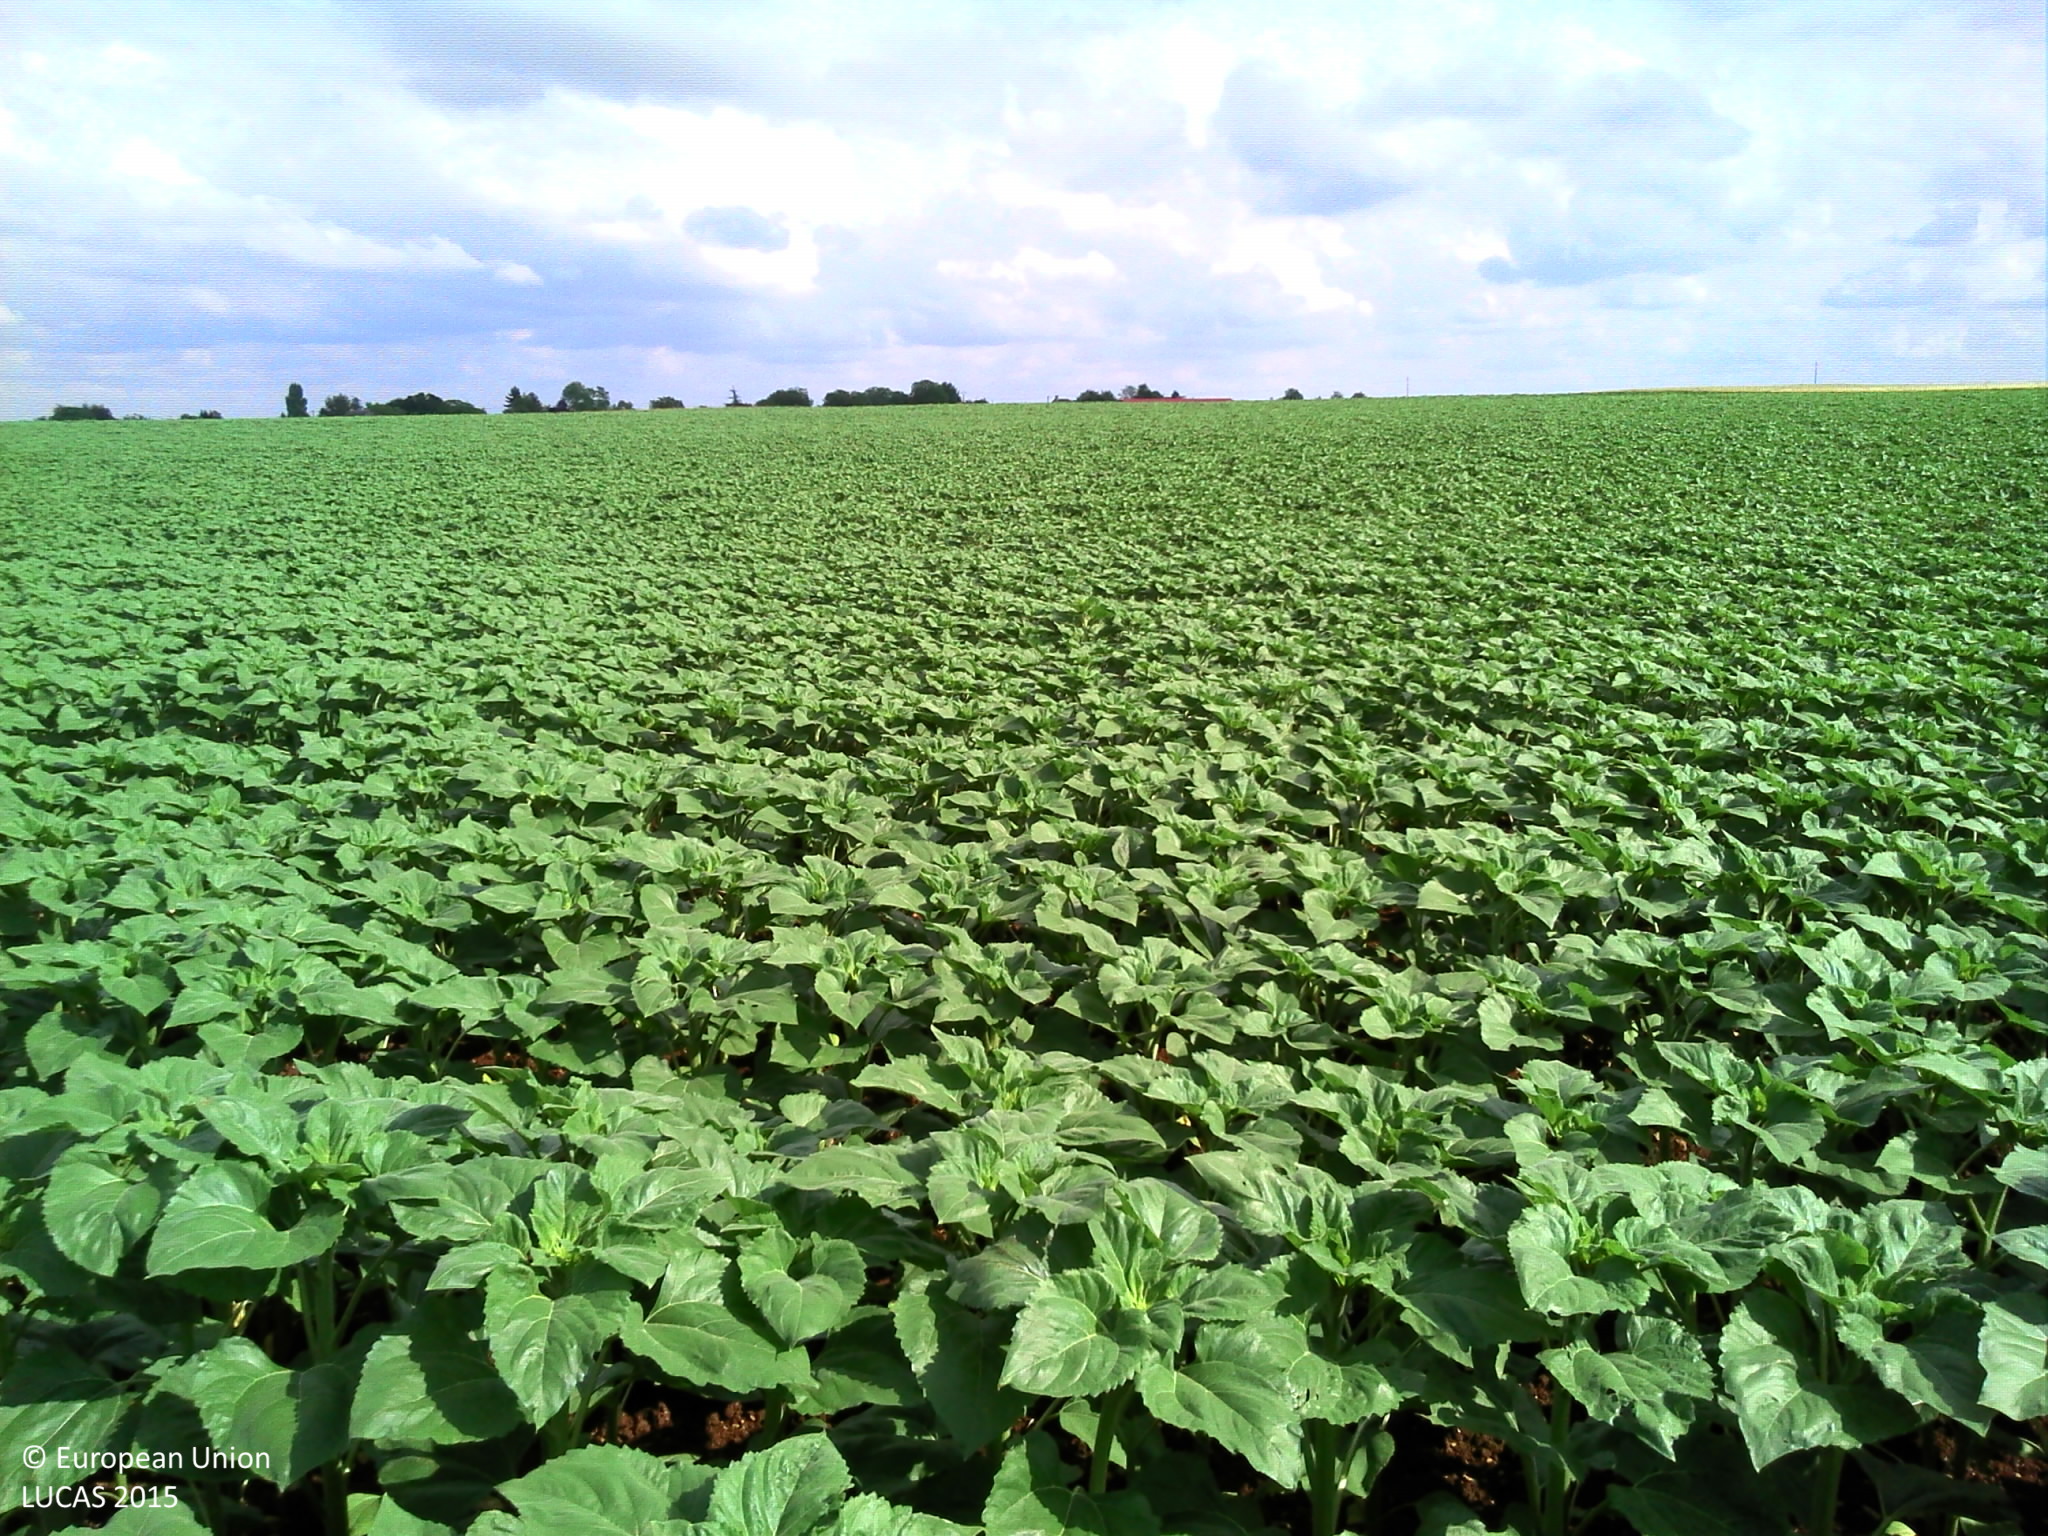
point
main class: Cropland
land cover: Sunflower
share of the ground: > 75 %
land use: Agriculture (excluding fallow land and kitchen gardens)
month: June
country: FR
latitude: 46.6991
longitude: 0.2100
